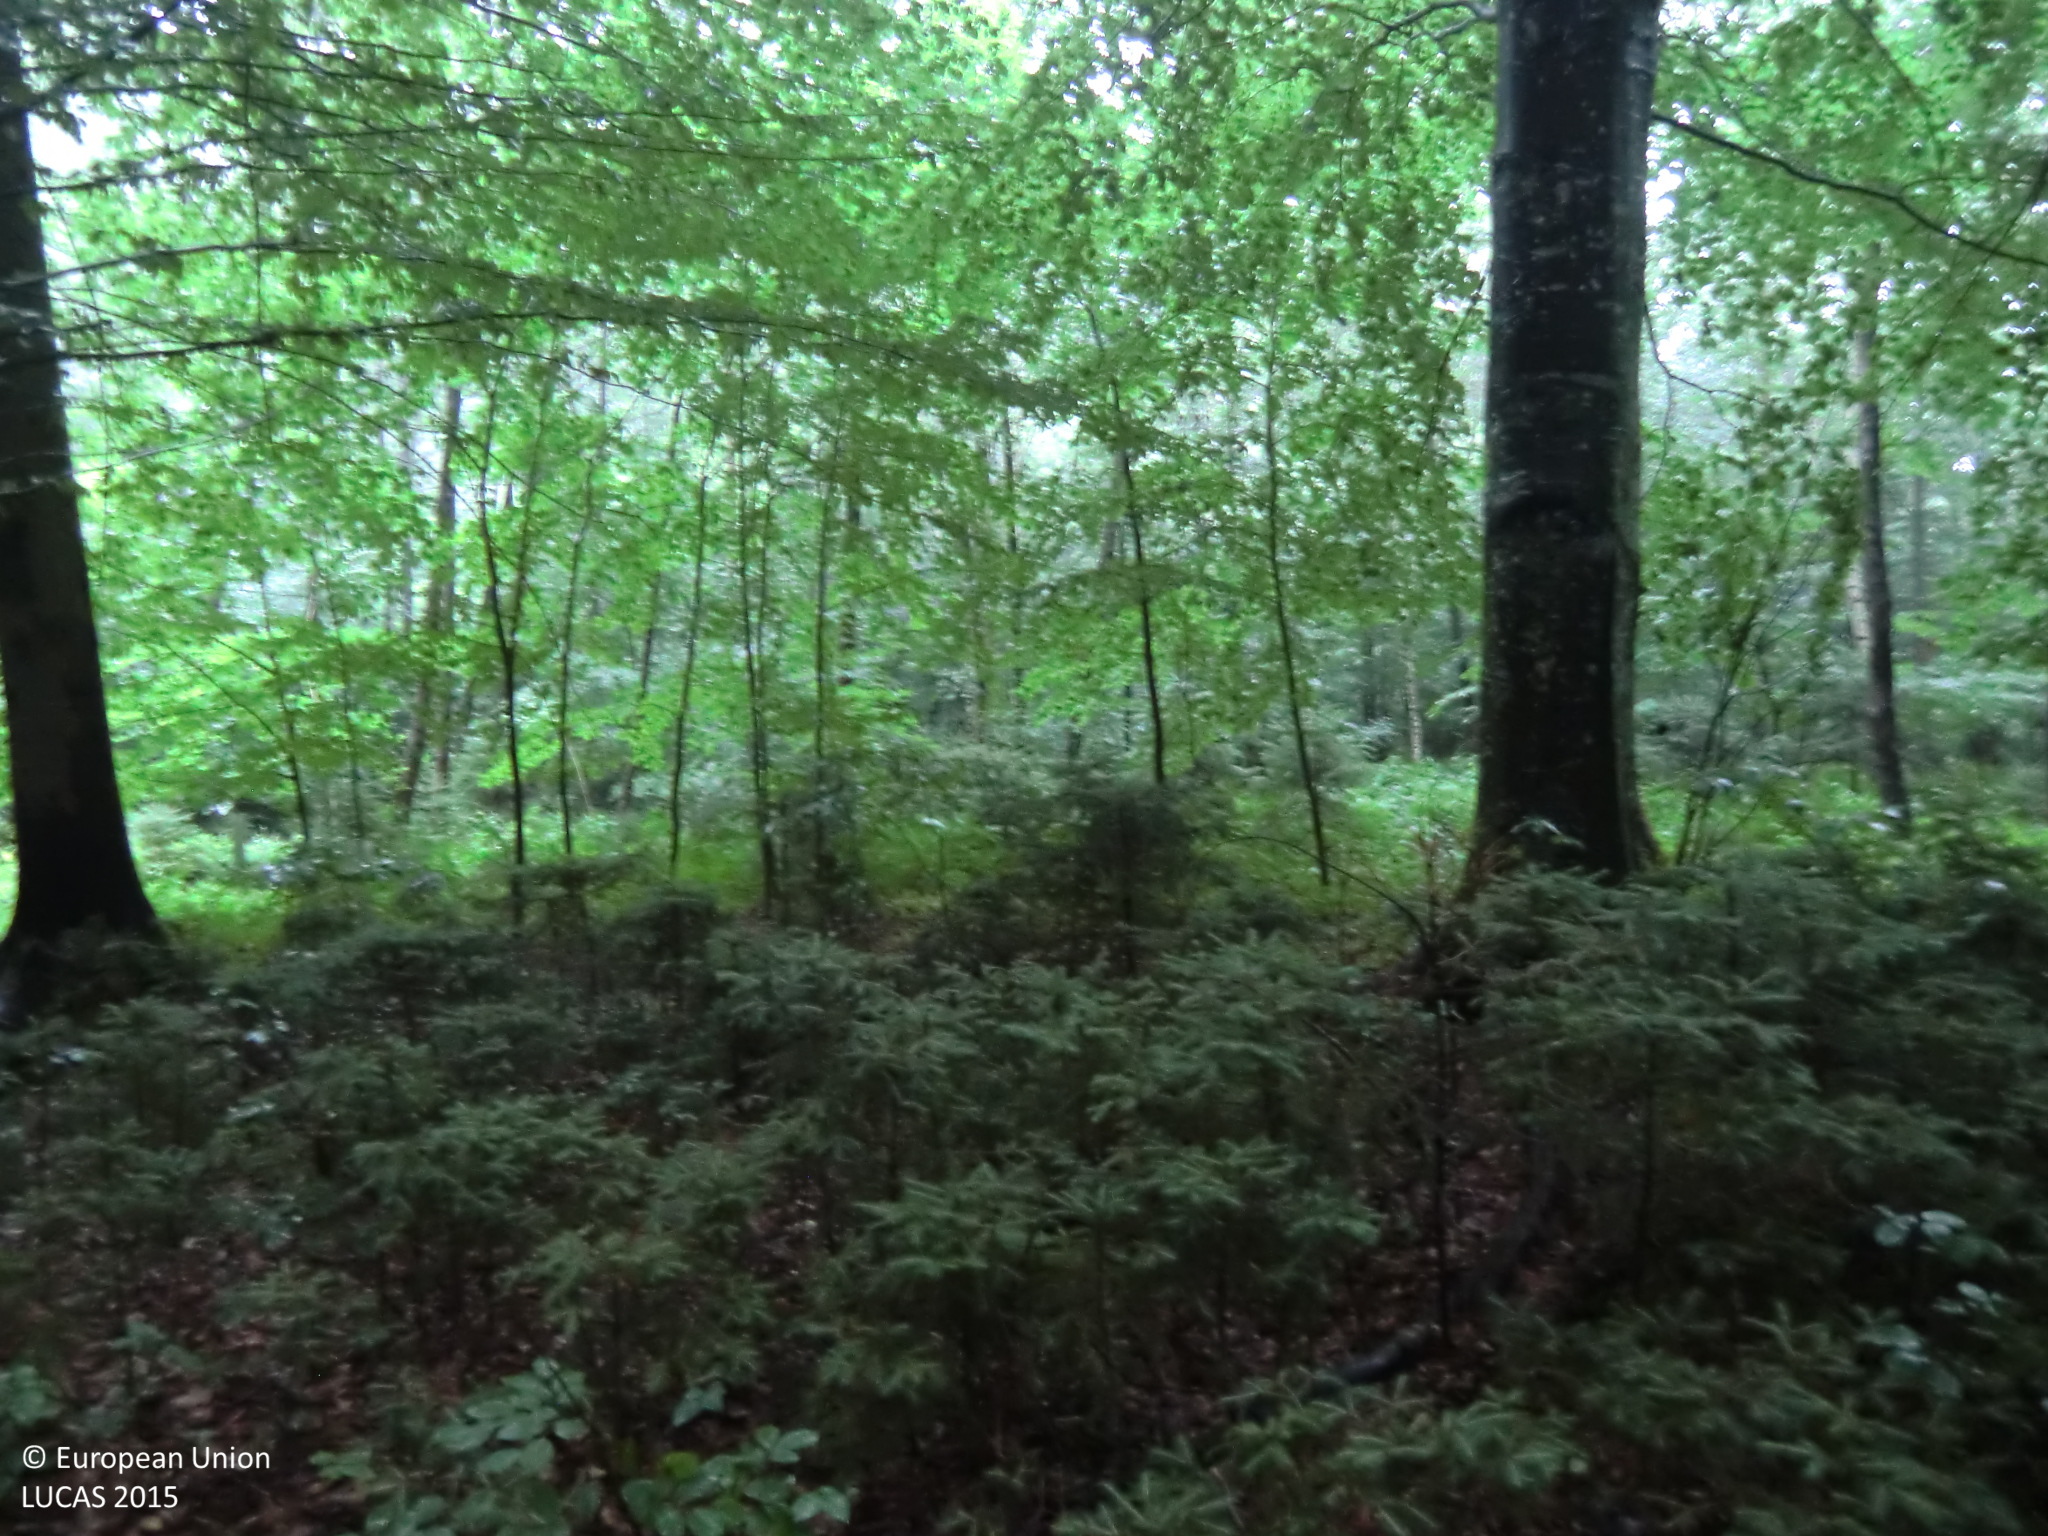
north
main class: Woodland
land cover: Broadleaved woodland
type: hemiboreal forest and nemoral coniferous forest and mixed broadleaved-coniferous forest
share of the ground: > 75 %
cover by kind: broadleaved forest trees 70 %, coniferous forest trees 15 %, herbaceous plants 15 %
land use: Forestry
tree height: > 5 m
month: July
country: AT
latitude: 47.0213
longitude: 15.8553
